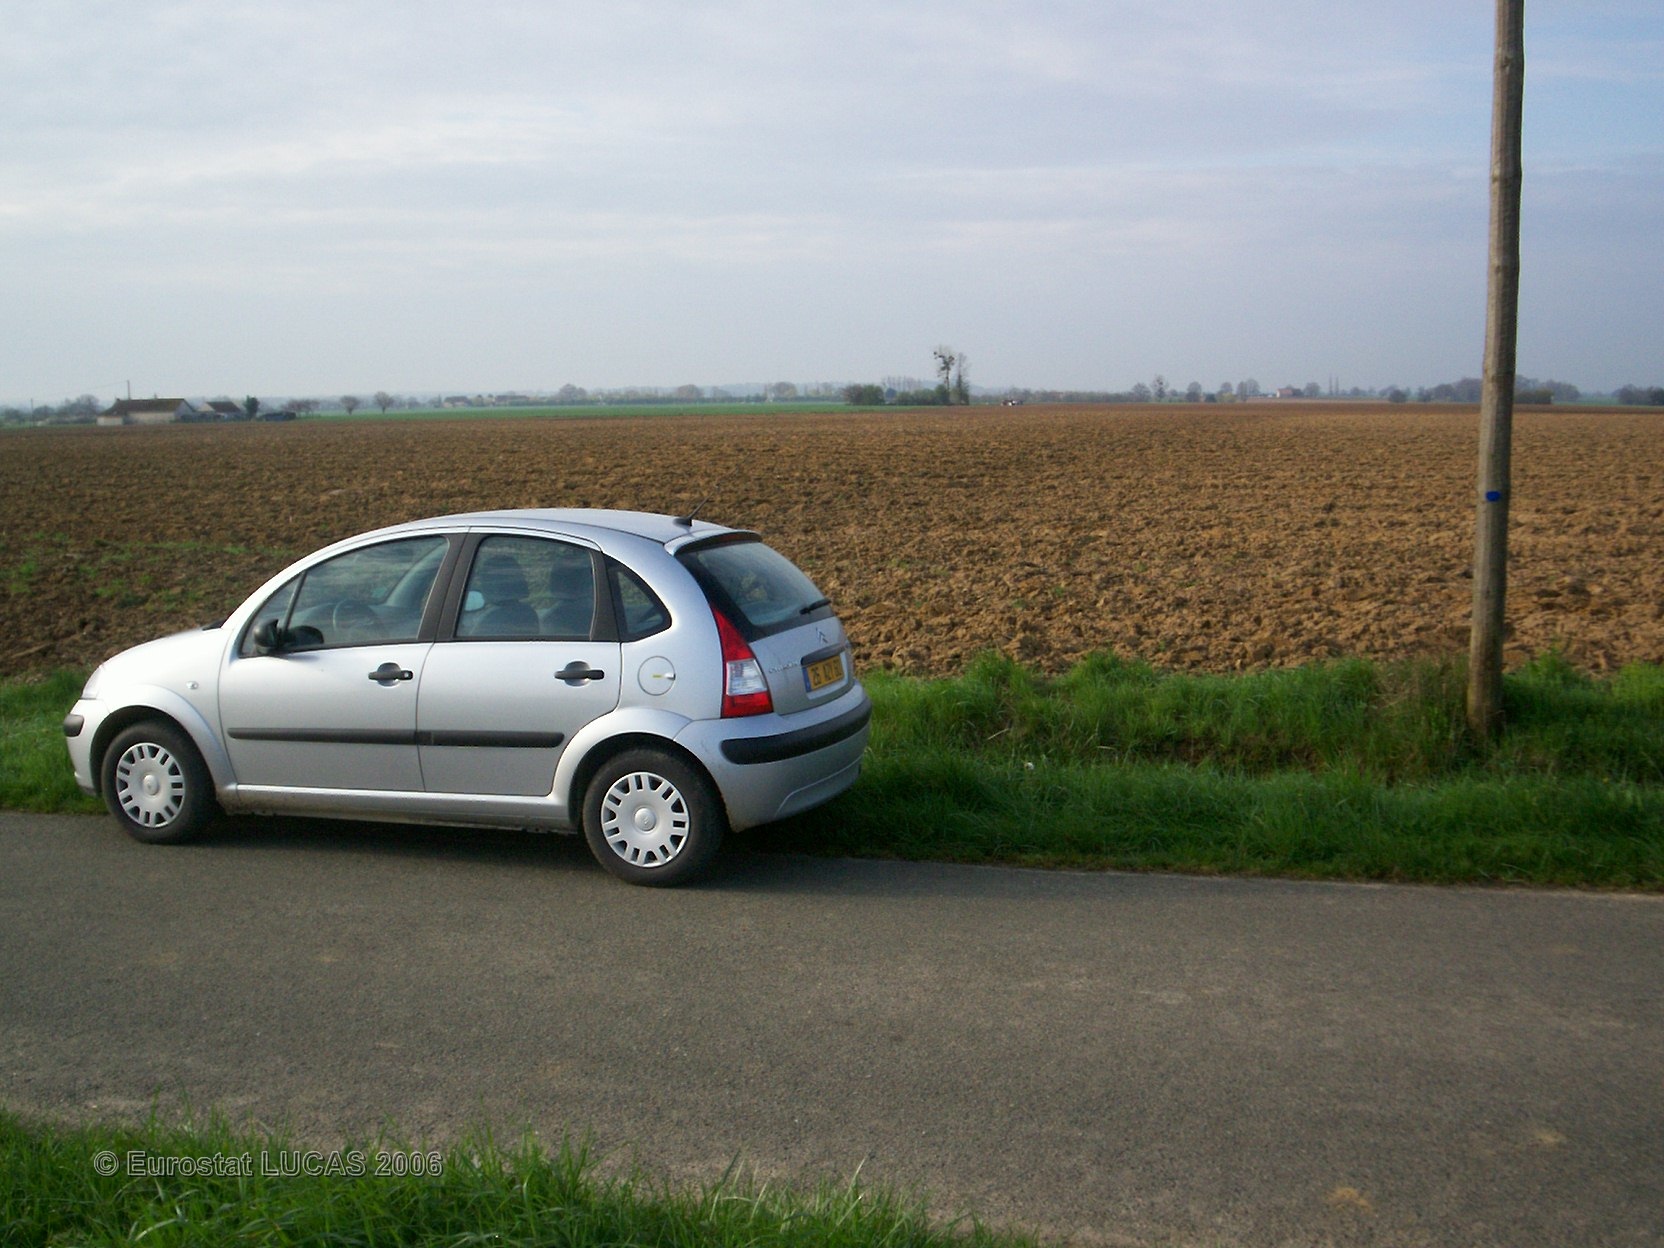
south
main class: Cropland
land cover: Dry pulses
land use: Agriculture (excluding fallow land and kitchen gardens)
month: April
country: FR
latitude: 48.2246
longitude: 0.2413
